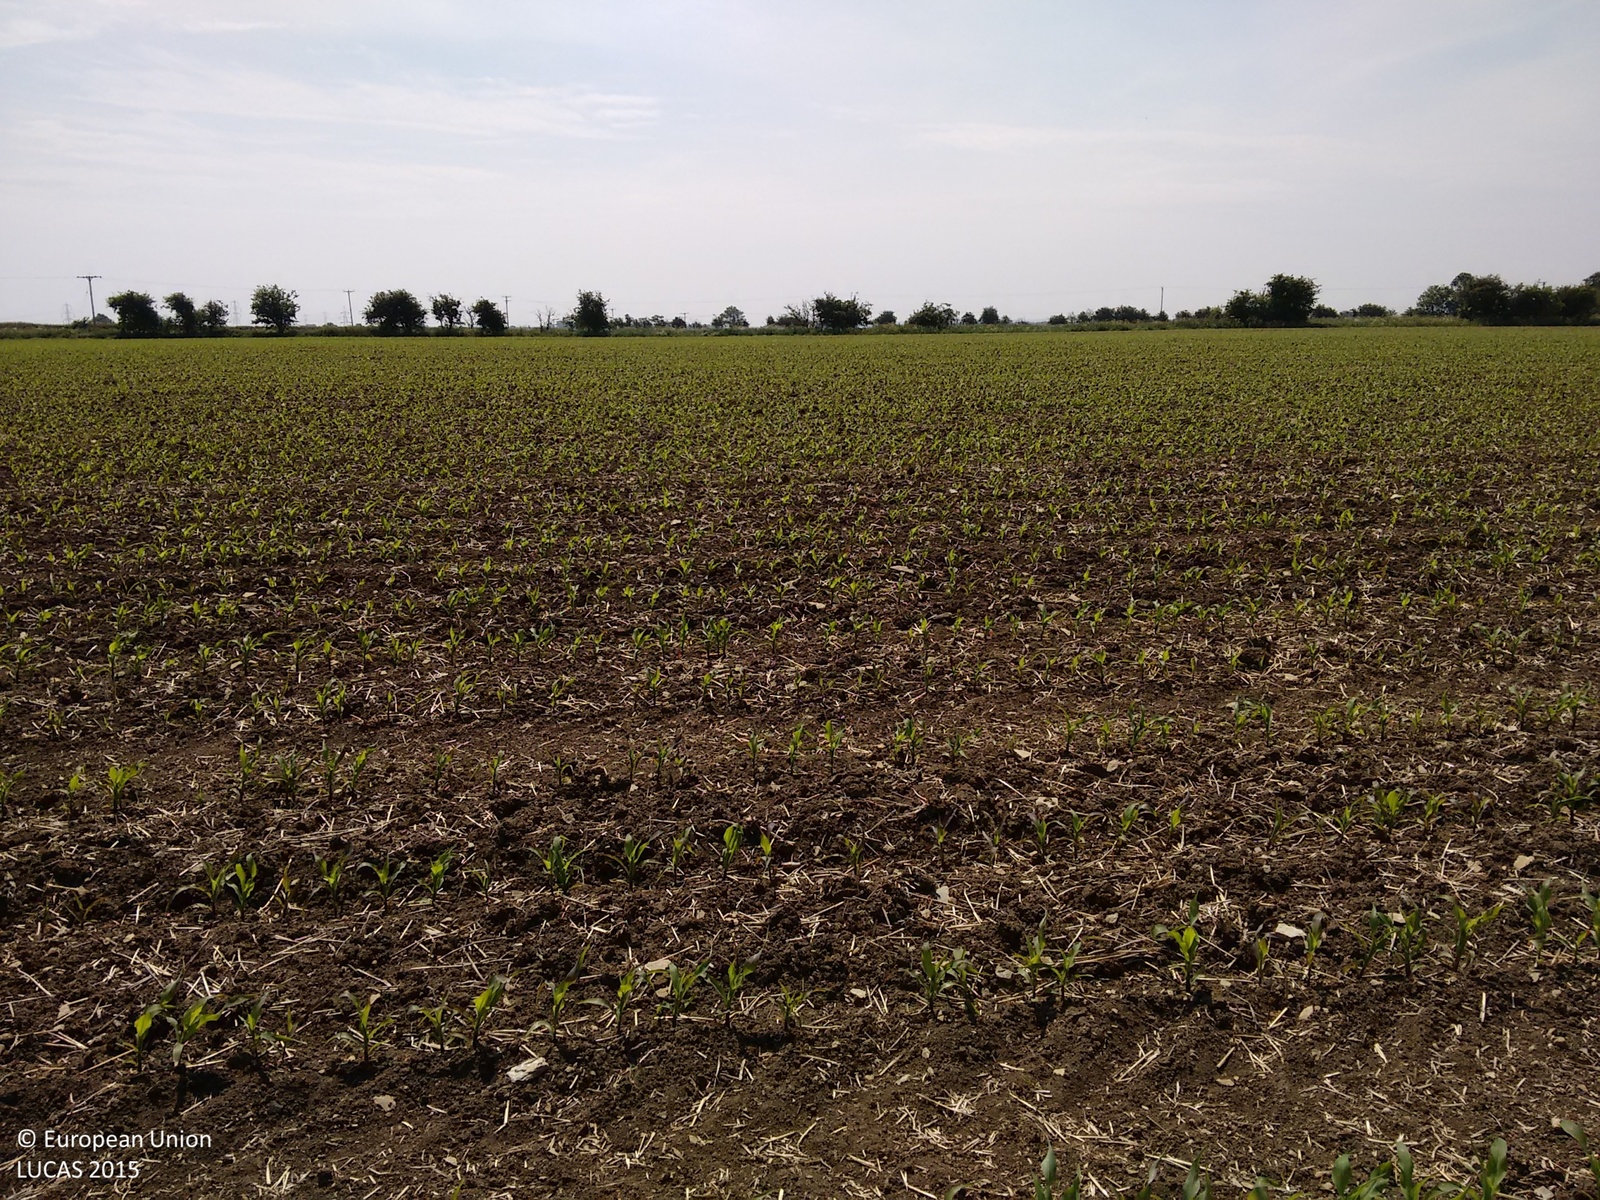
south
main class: Cropland
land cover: Maize
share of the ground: 10 - 25 %
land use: Agriculture (excluding fallow land and kitchen gardens)
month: June
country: GB
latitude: 53.0093
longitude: -0.7868
